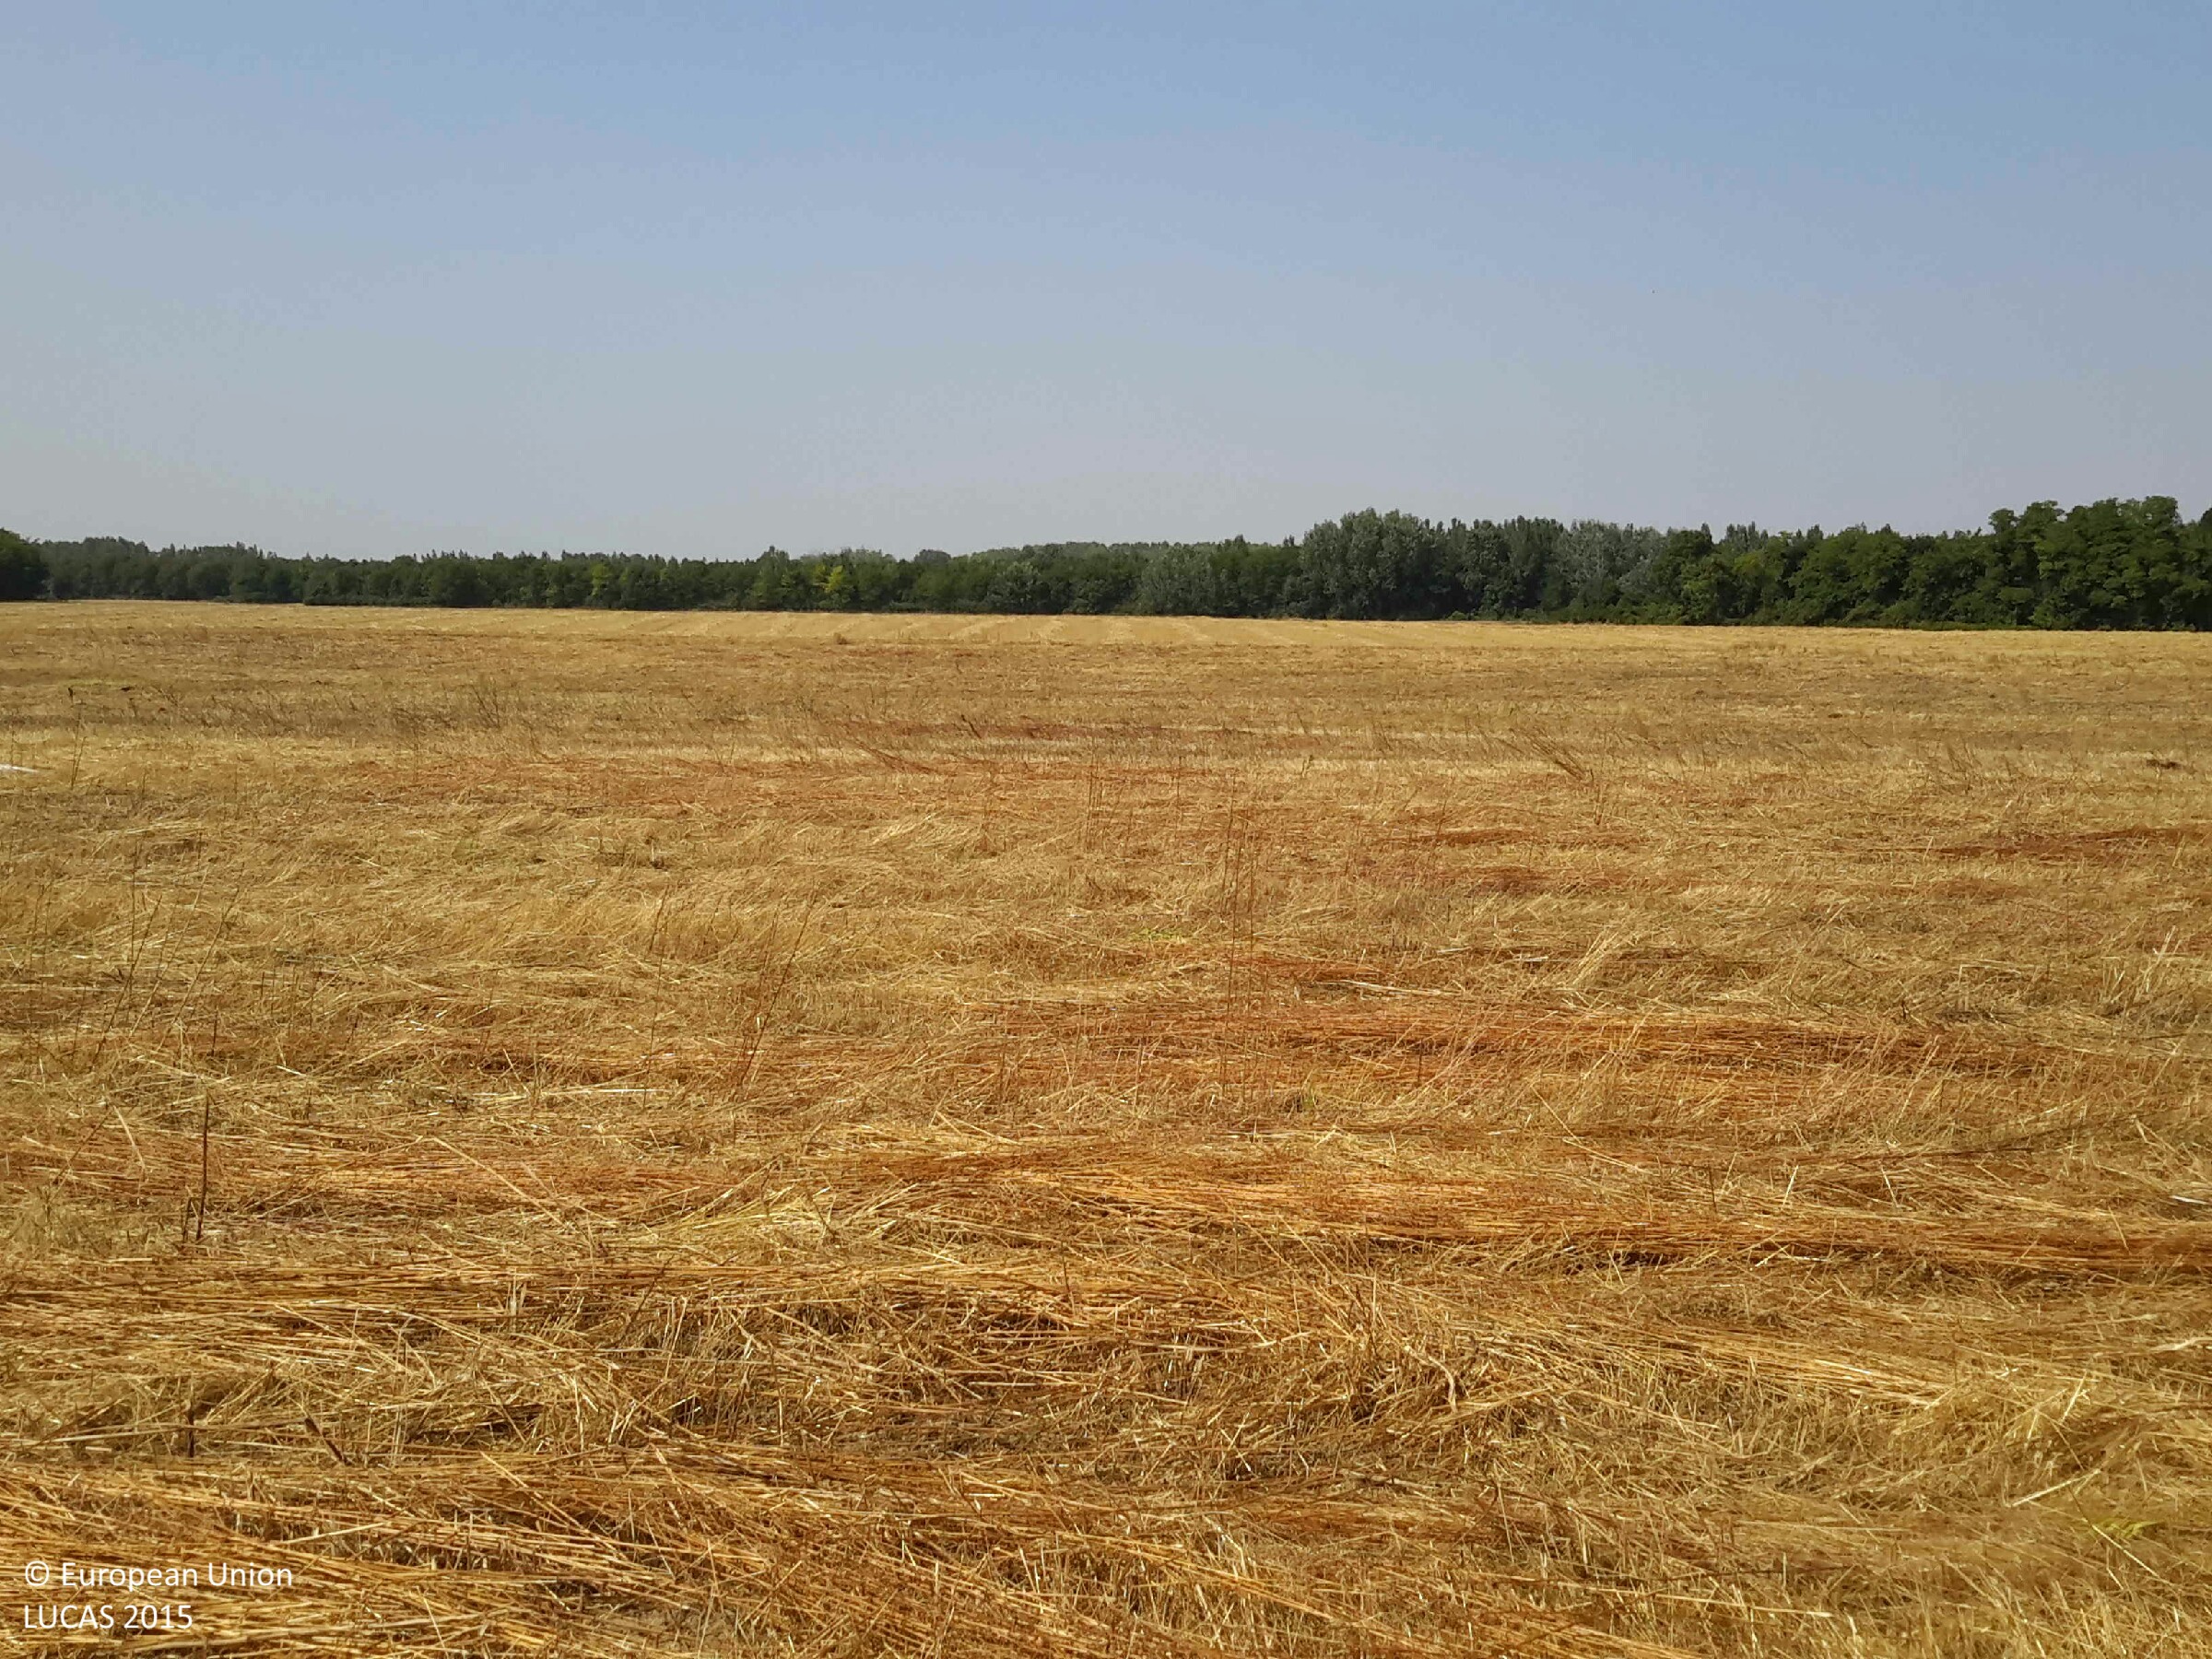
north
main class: Cropland
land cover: Temporary grasslands
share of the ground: > 75 %
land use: Agriculture (excluding fallow land and kitchen gardens)
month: August
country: HU
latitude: 47.8912
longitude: 17.2973
